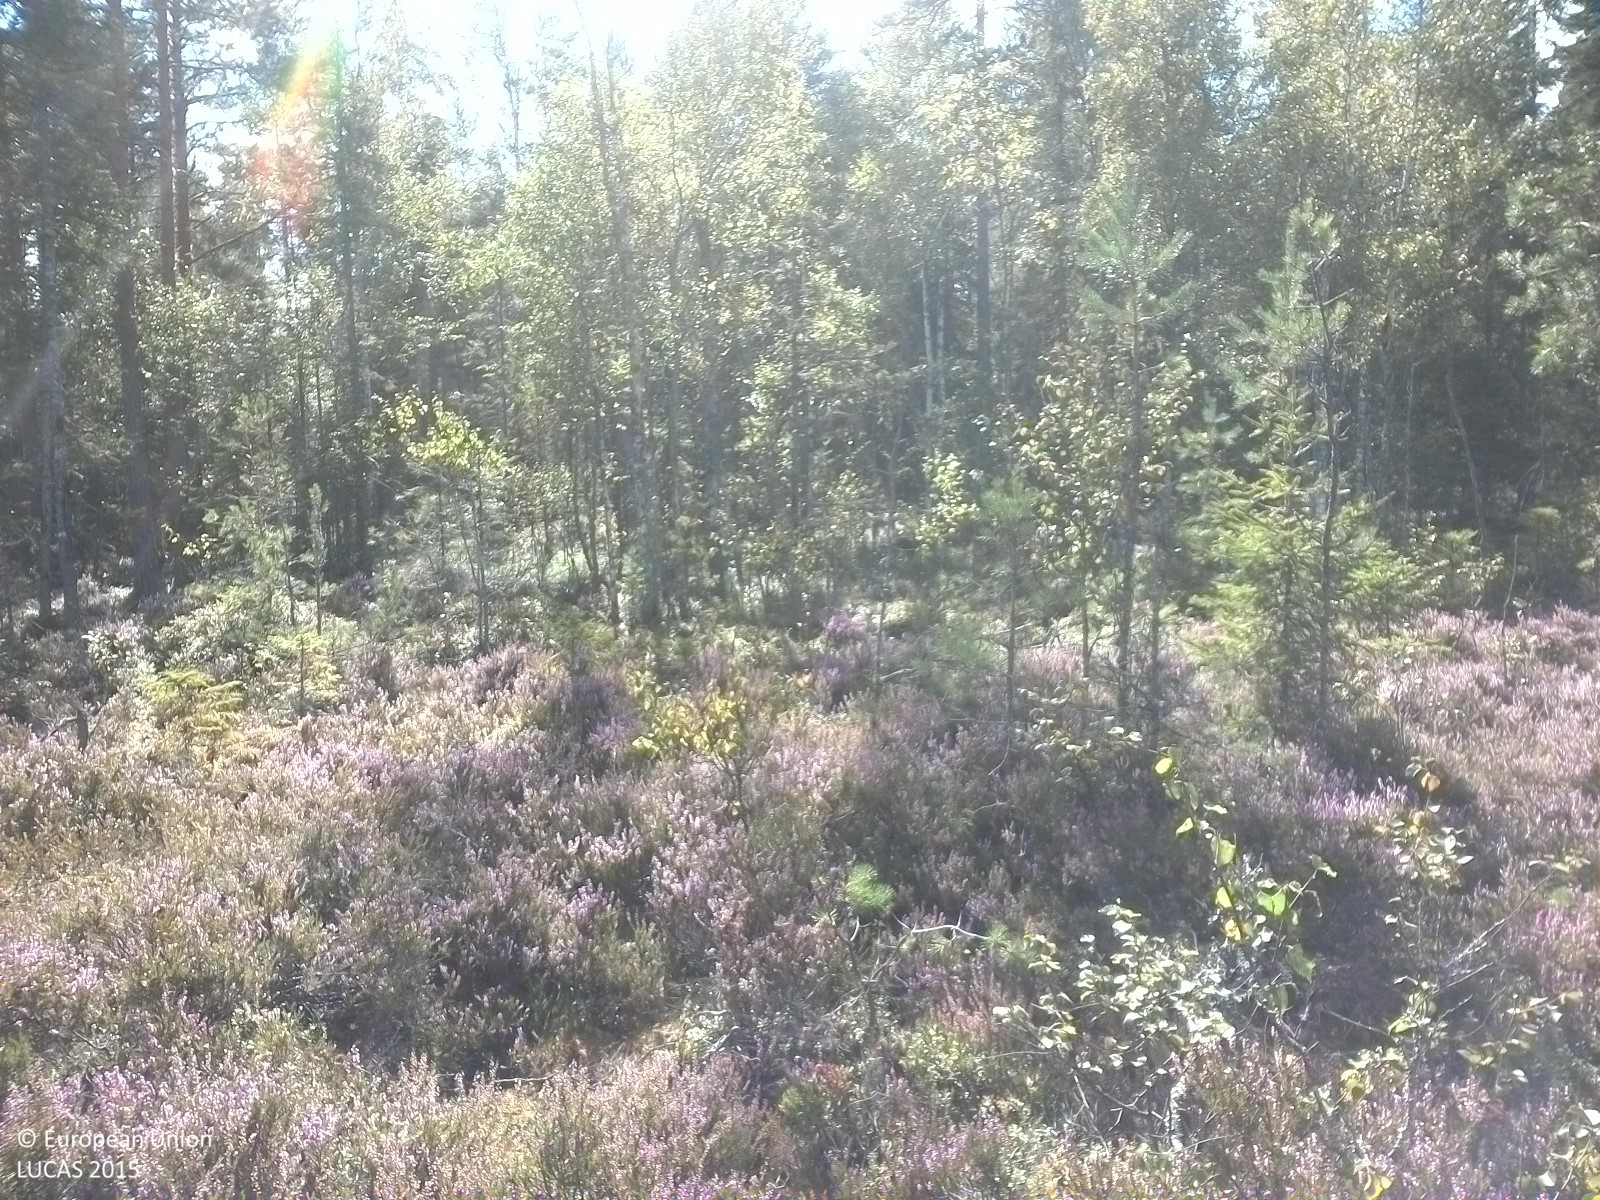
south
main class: Shrubland
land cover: Shrubland with sparse tree cover
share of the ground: 50 - 75 %
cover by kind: shrubs 70 %, lichens and mosses 20 %, coniferous forest trees 5 %, herbaceous plants 5 %
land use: Semi-natural and natural areas not in use
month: August
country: SE
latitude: 59.0730
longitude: 15.6970
